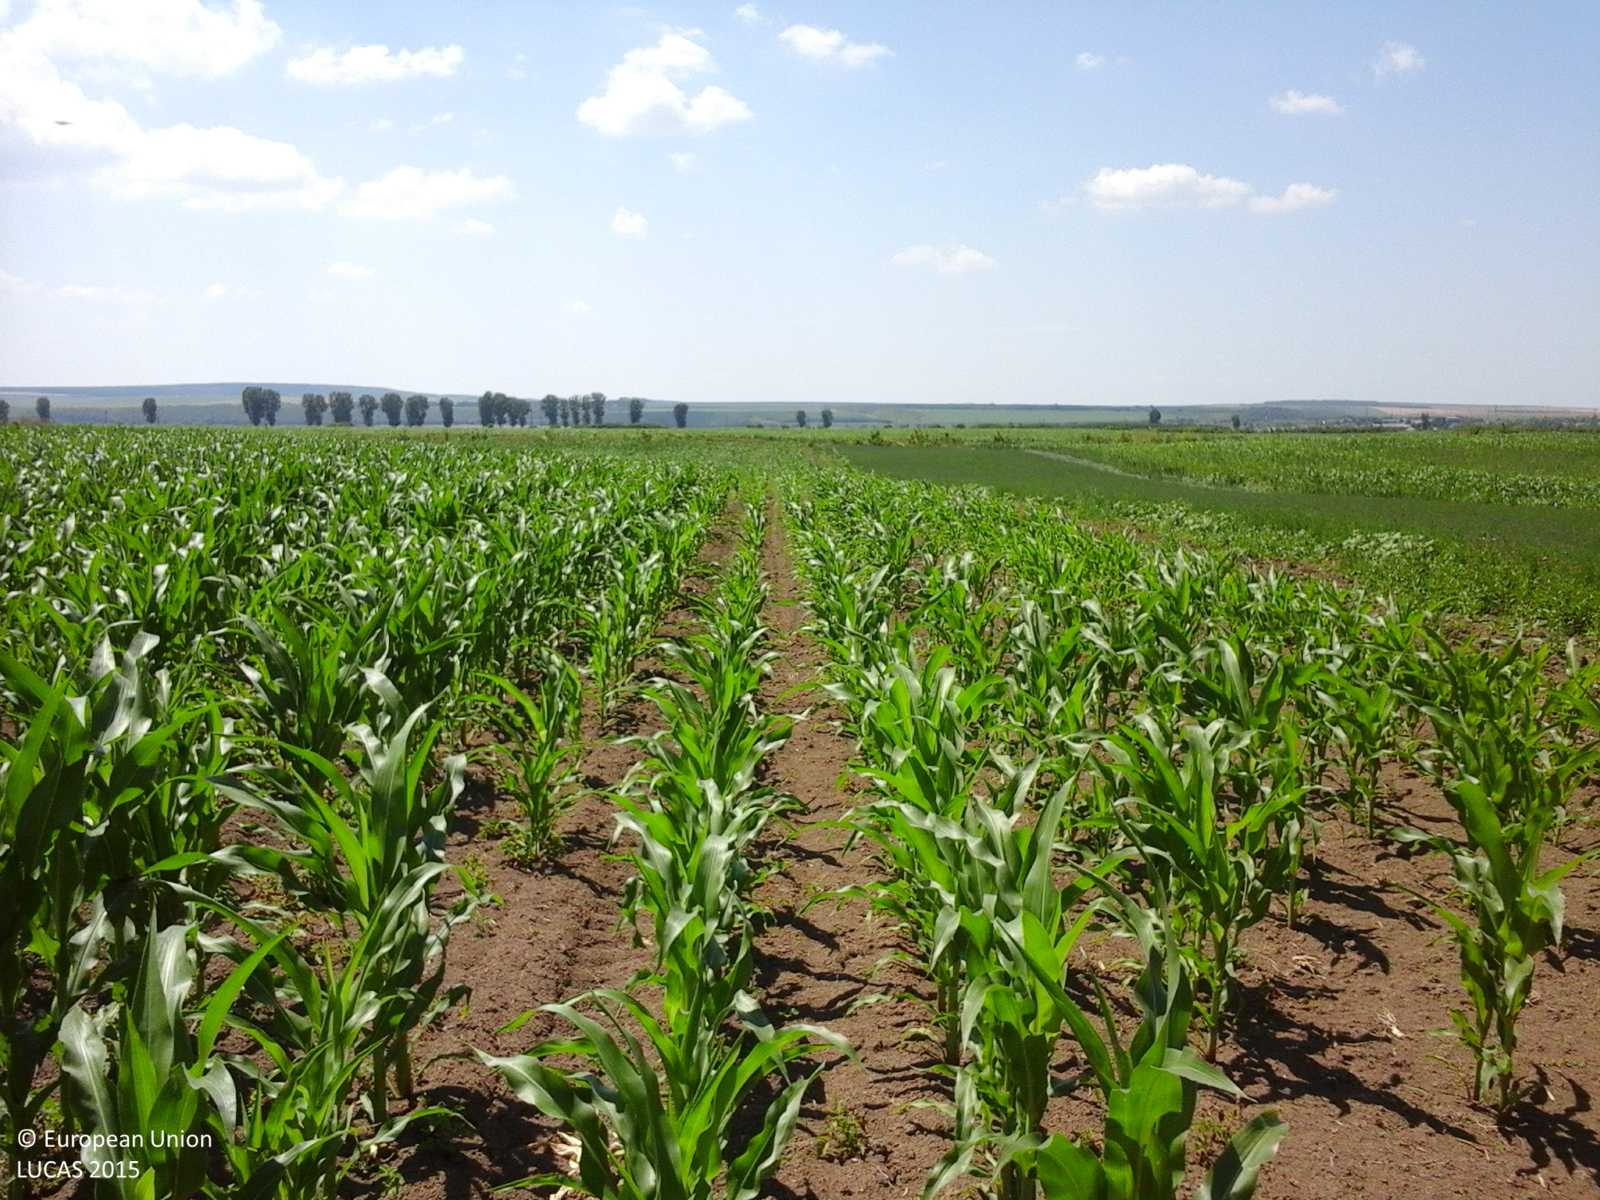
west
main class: Cropland
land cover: Maize
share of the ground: 50 - 75 %
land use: Agriculture (excluding fallow land and kitchen gardens)
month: June
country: RO
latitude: 47.4481
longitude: 27.5321
